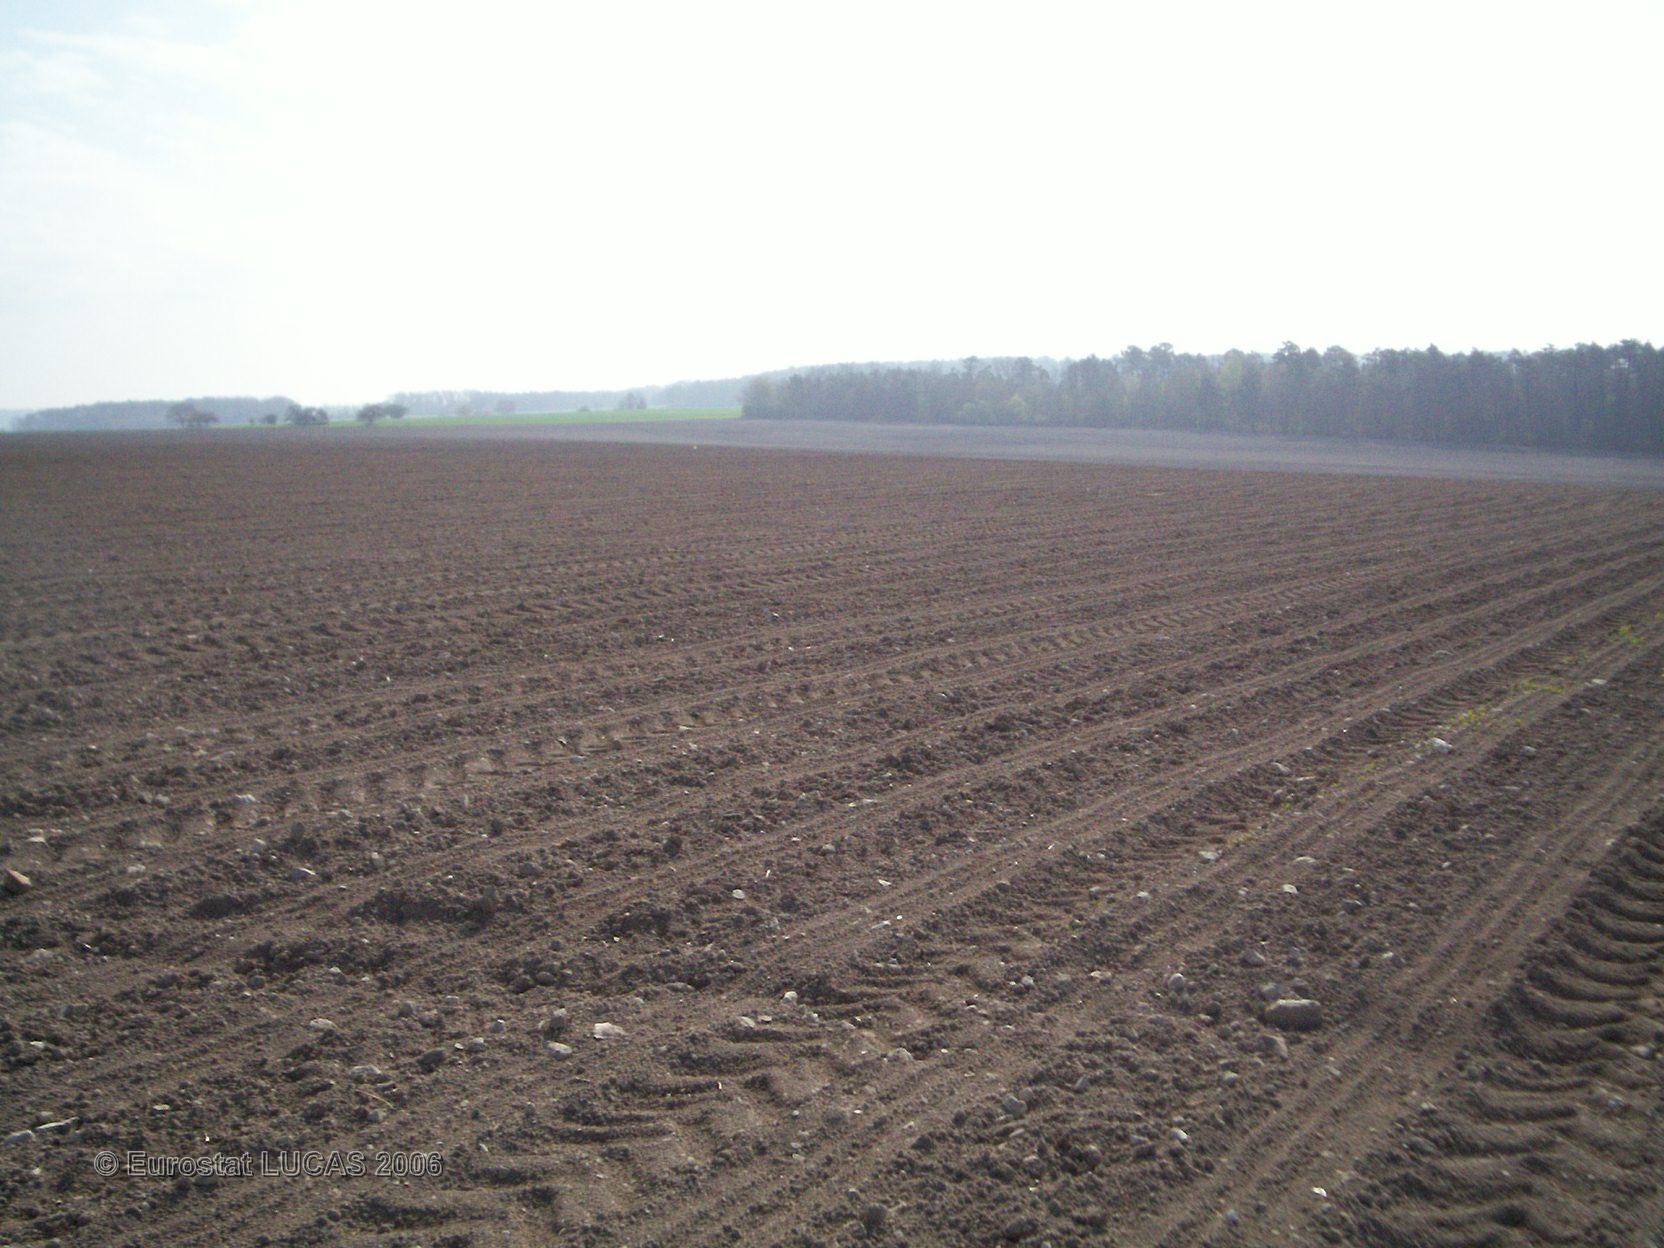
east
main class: Bare land
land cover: Bare land
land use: Agriculture (excluding fallow land and kitchen gardens)
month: April
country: FR
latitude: 46.8807
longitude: 0.4143
